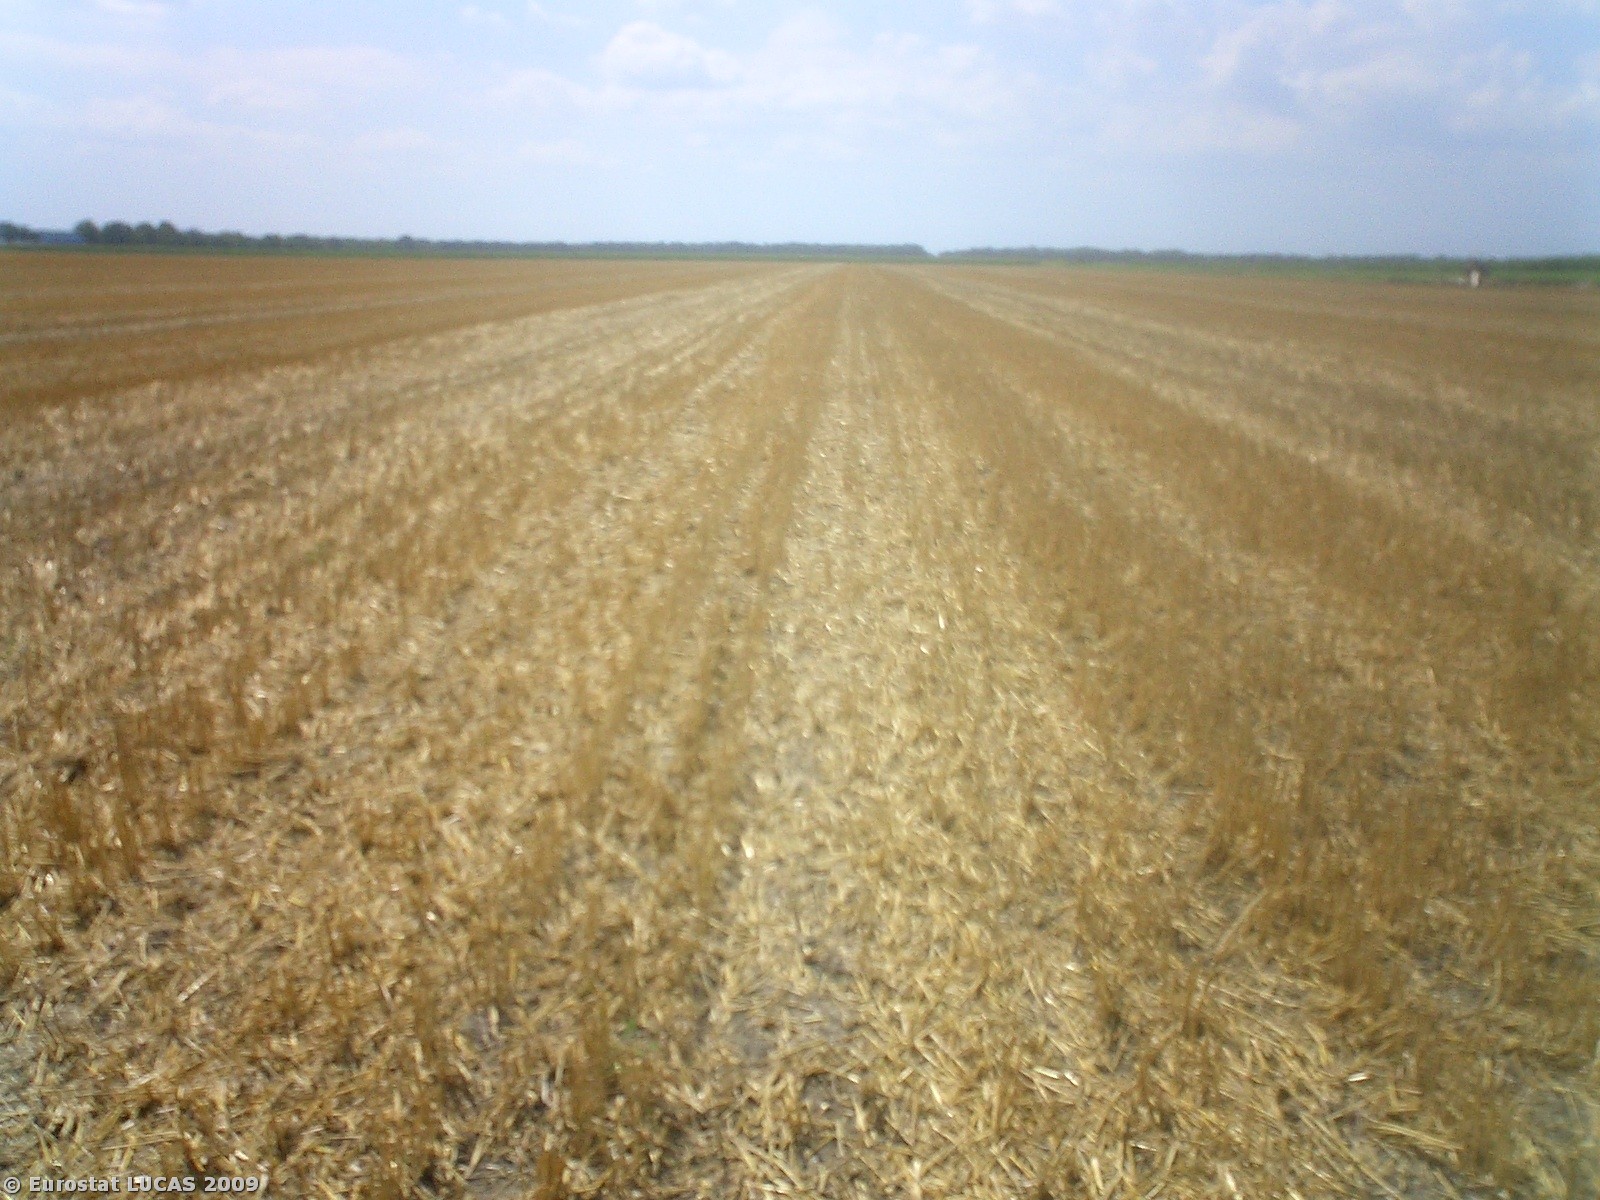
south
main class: Cropland
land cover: Common wheat
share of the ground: > 75 %
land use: Agriculture (excluding fallow land and kitchen gardens)
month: July
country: IT
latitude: 44.7091
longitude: 12.0533
